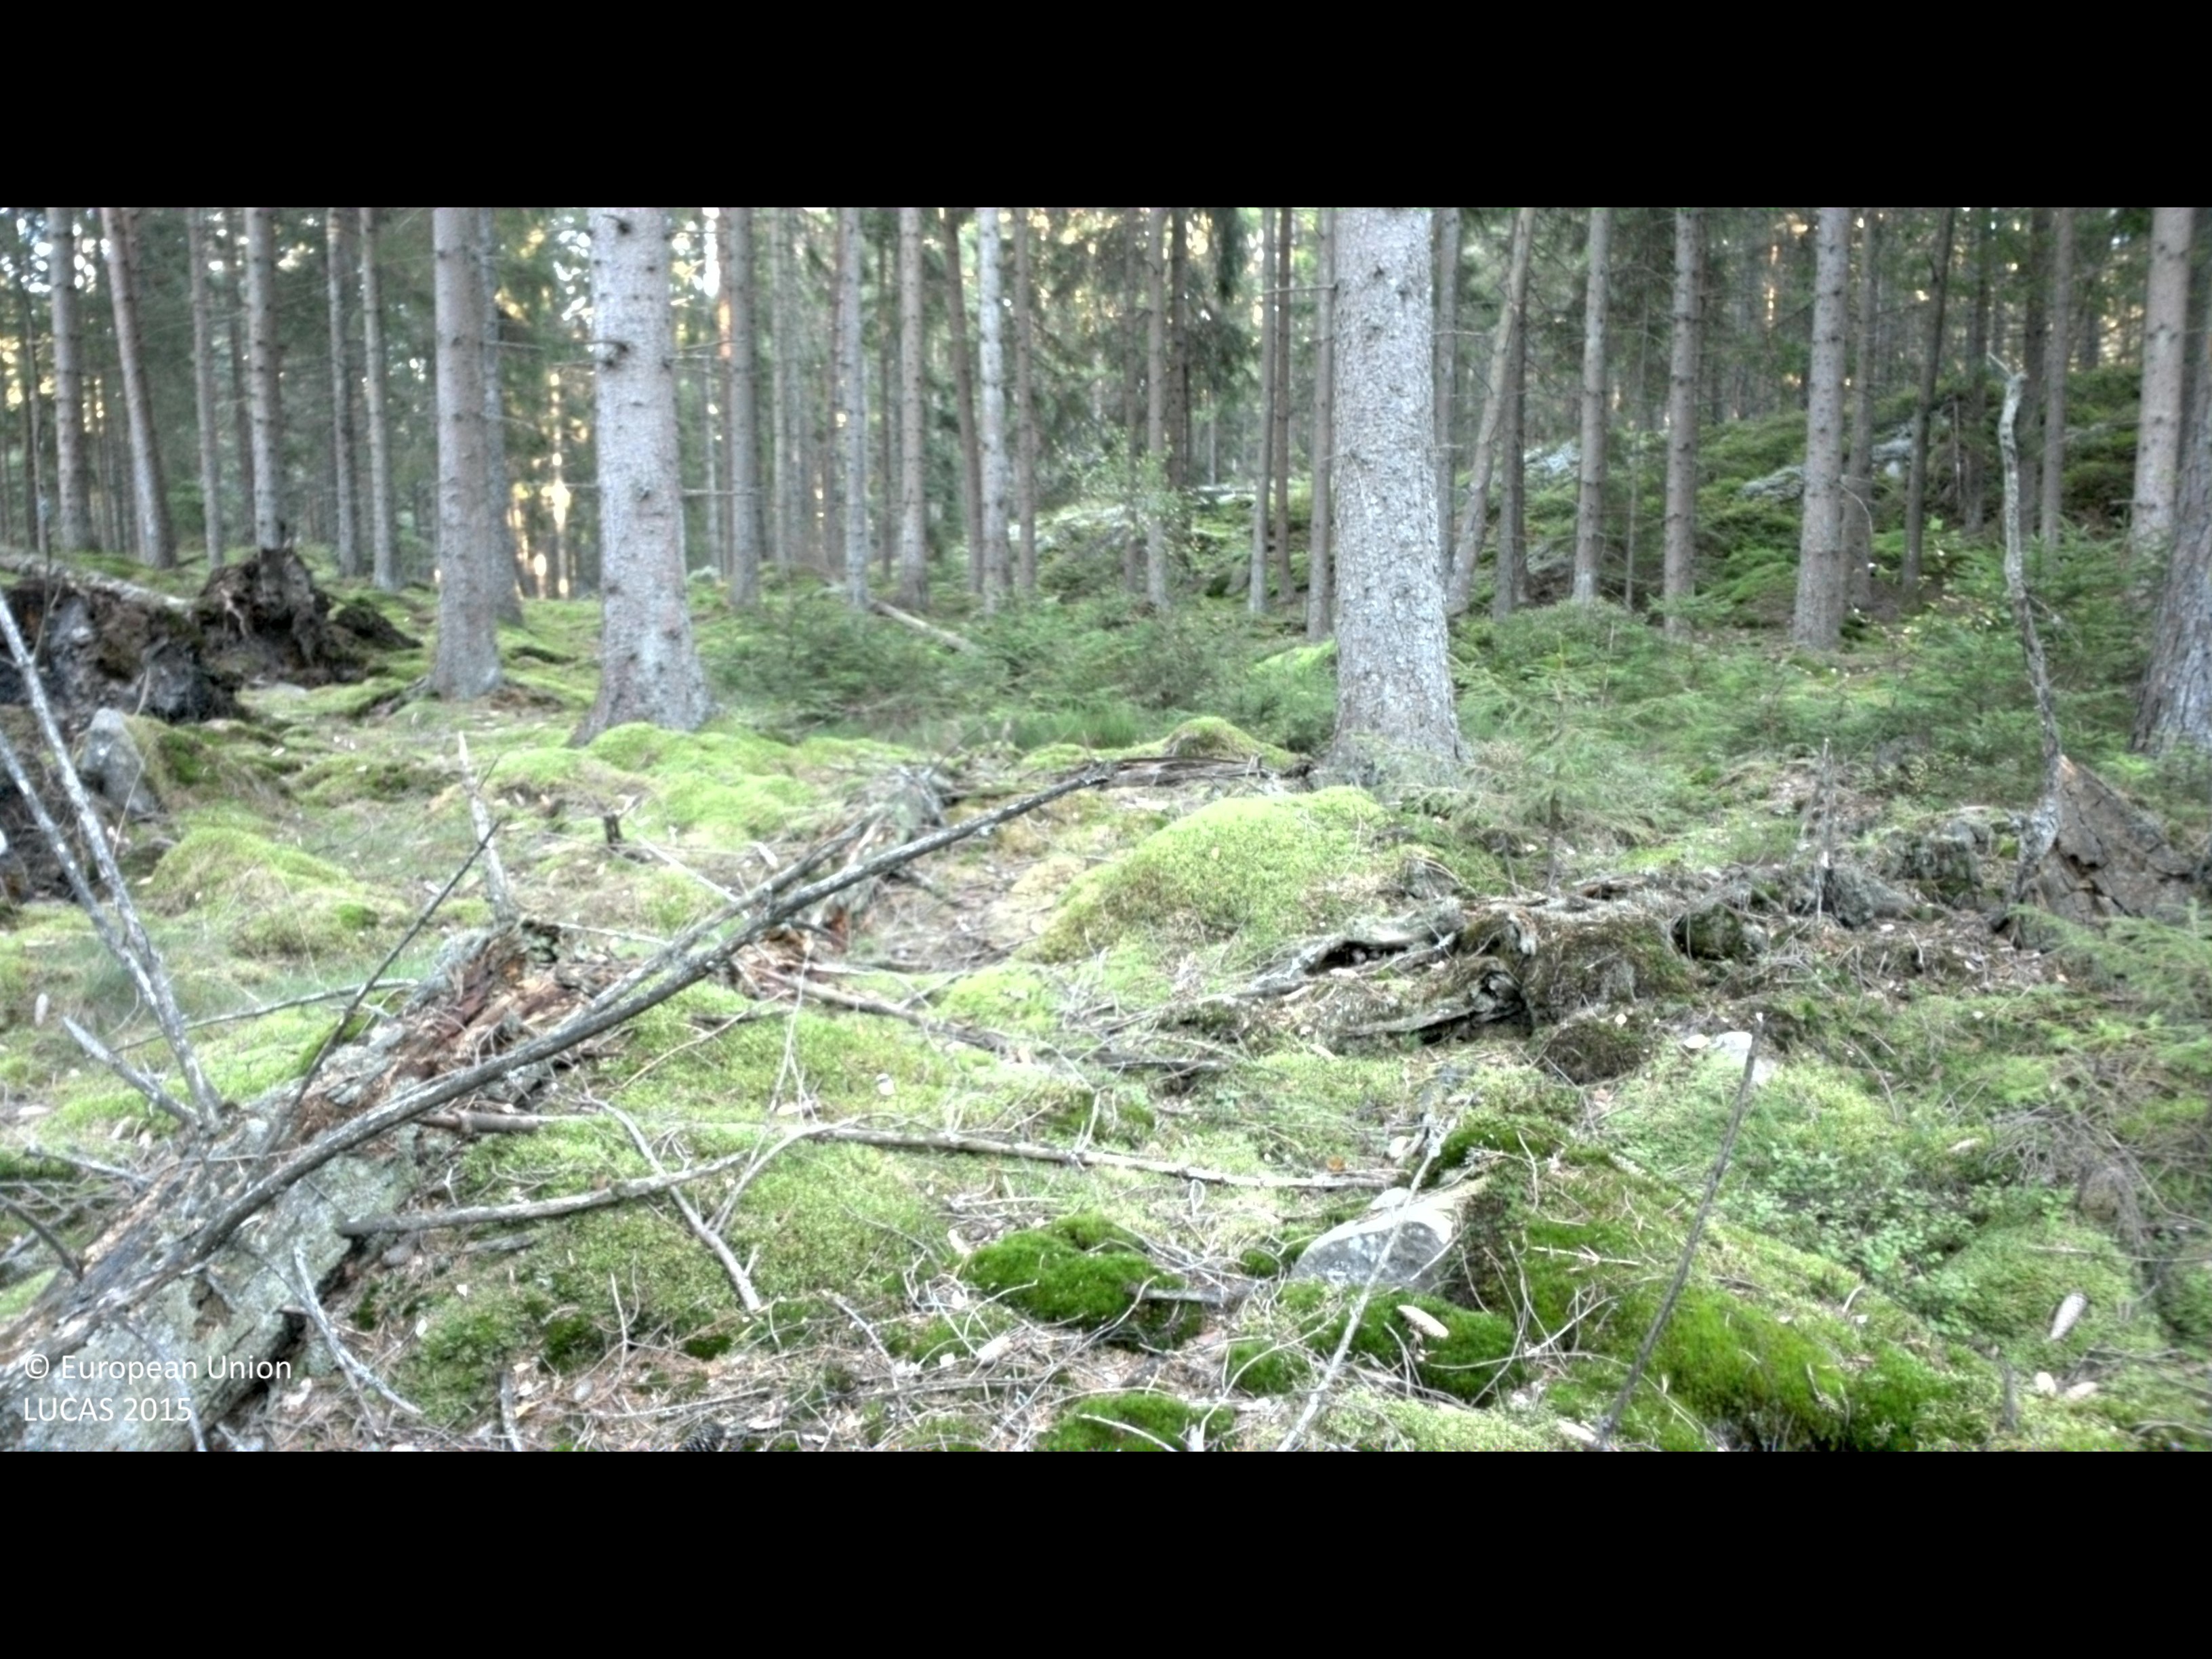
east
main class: Woodland
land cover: Spruce dominated coniferous woodland
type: boreal forest
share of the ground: > 75 %
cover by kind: coniferous forest trees 75 %, lichens and mosses 25 %
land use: Forestry
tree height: > 5 m
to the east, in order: Spruce dominated coniferous woodland
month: September
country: SE
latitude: 56.2394
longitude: 14.3703
